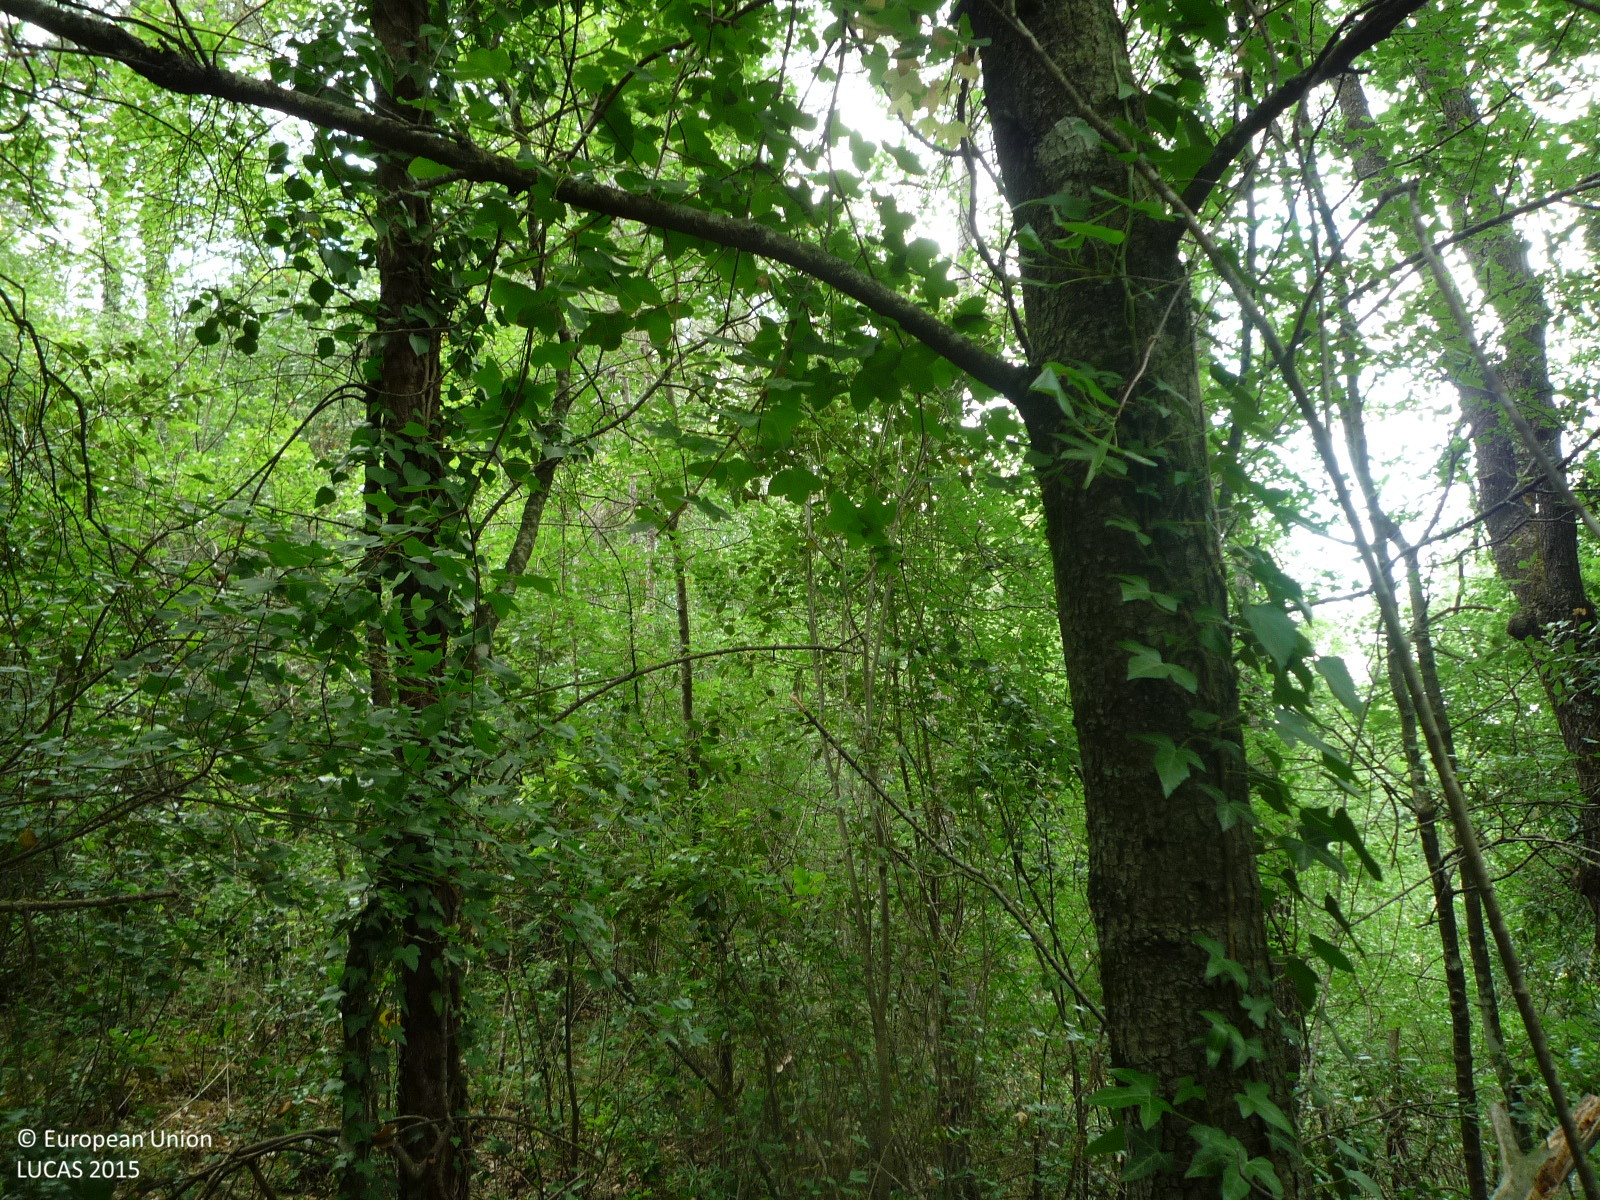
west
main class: Woodland
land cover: Pine dominated mixed woodland
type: coniferous forest of the mediterranean region
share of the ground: > 75 %
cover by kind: coniferous forest trees 60 %, broadleaved forest trees 40 %
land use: Forestry
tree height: > 5 m
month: June
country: ES
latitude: 41.8118
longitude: 2.0102
